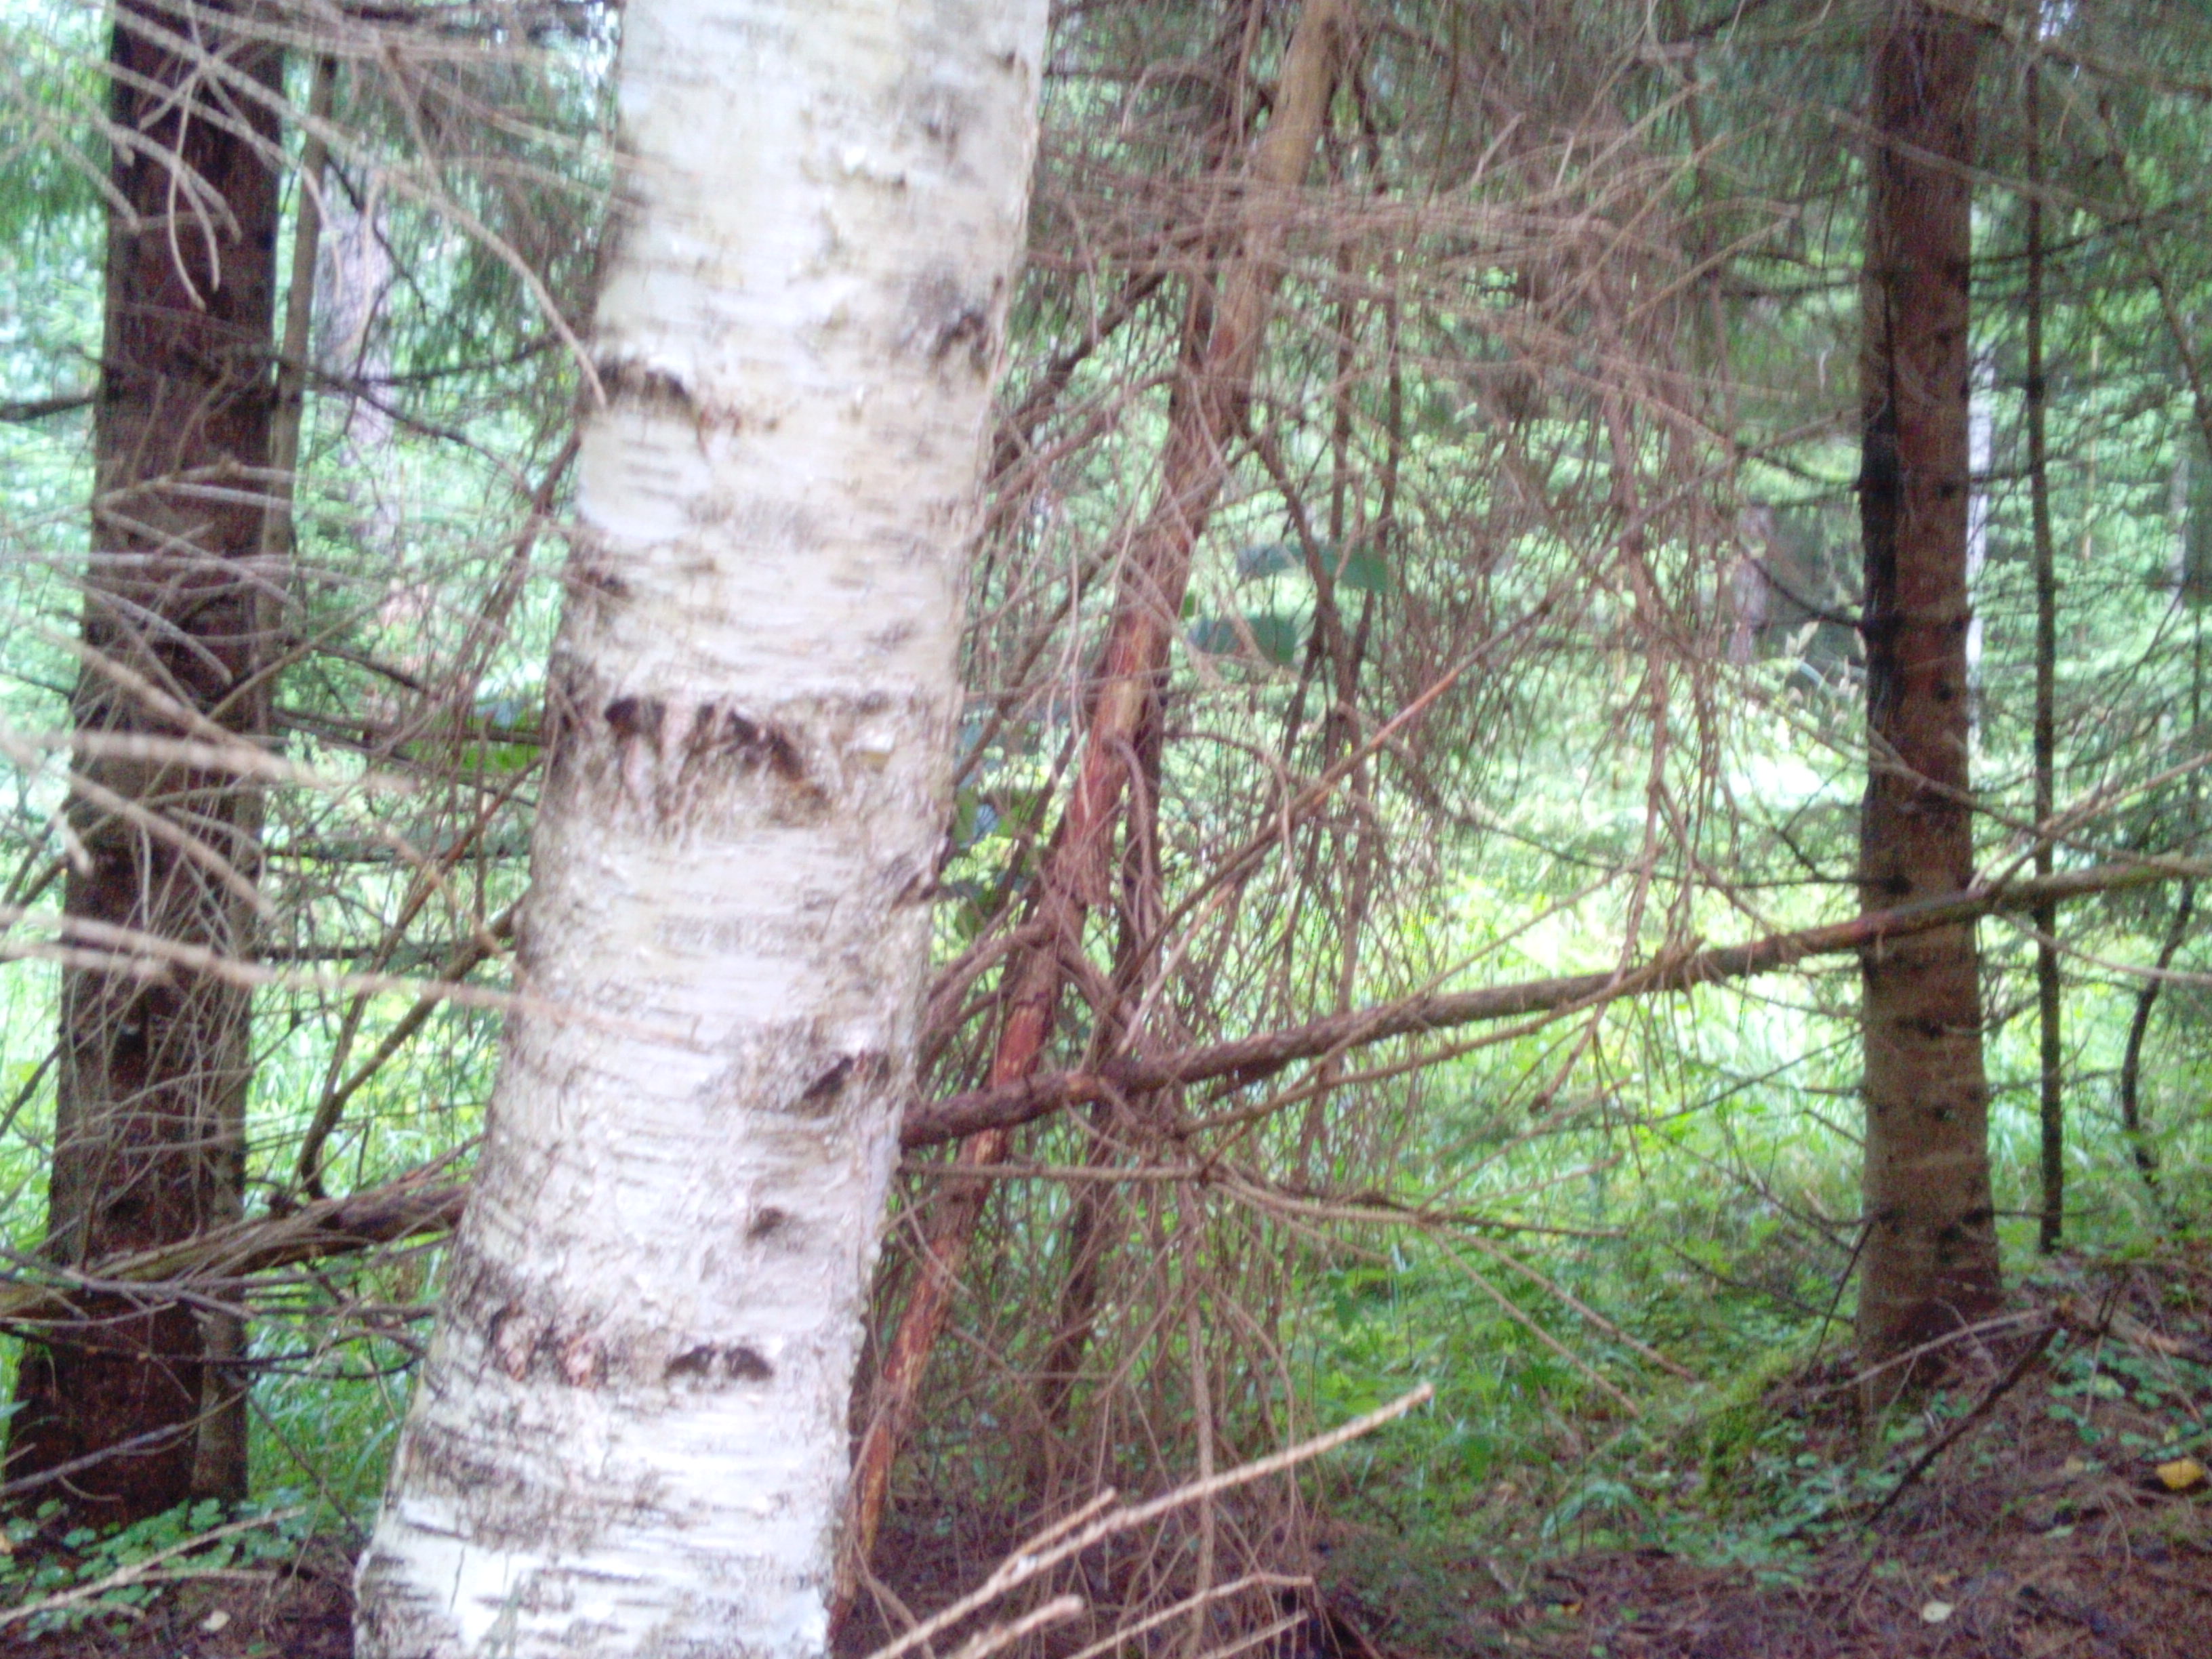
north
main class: Woodland
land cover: Spruce dominated mixed woodland
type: hemiboreal forest and nemoral coniferous forest and mixed broadleaved-coniferous forest
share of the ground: > 75 %
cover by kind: coniferous forest trees 50 %, broadleaved forest trees 25 %, herbaceous plants 25 %
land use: Forestry
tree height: > 5 m
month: July
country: LV
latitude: 57.0011
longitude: 22.0497
